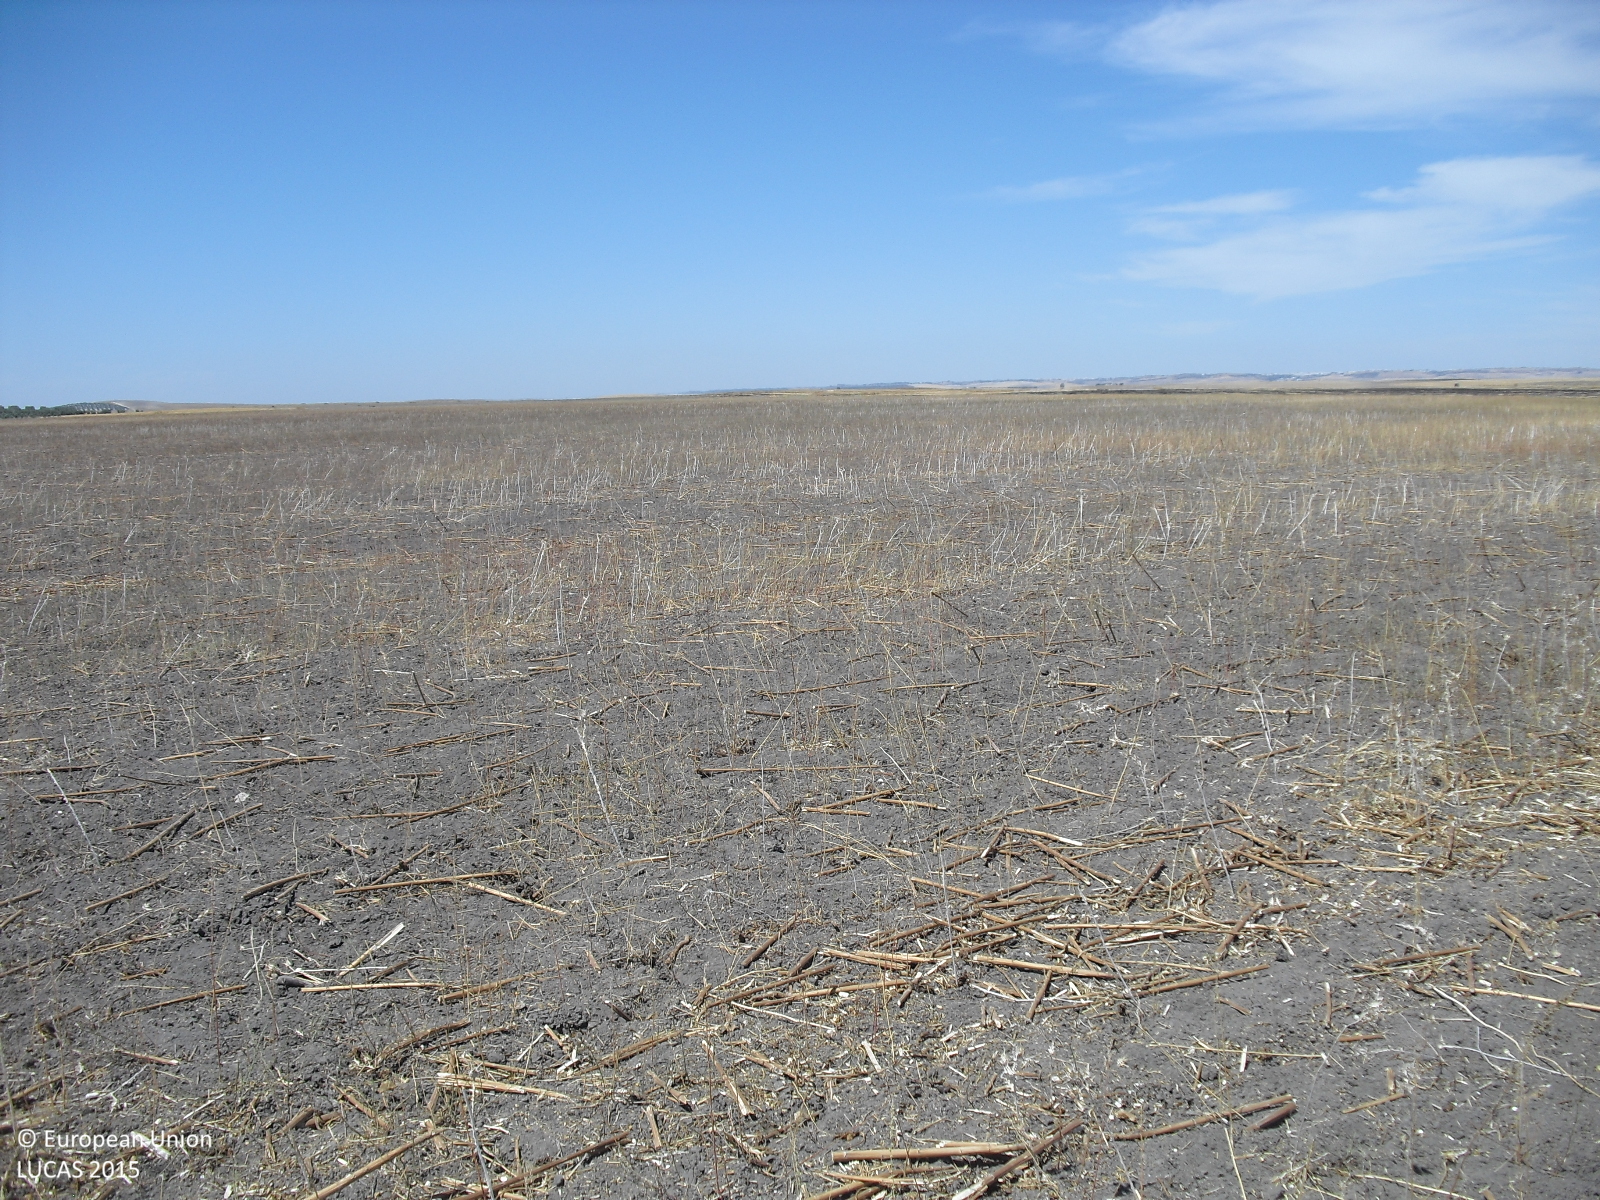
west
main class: Cropland
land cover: Sunflower
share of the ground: < 10 %
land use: Agriculture (excluding fallow land and kitchen gardens)
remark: Harvested field
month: August
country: ES
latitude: 37.3286
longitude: -5.5333
